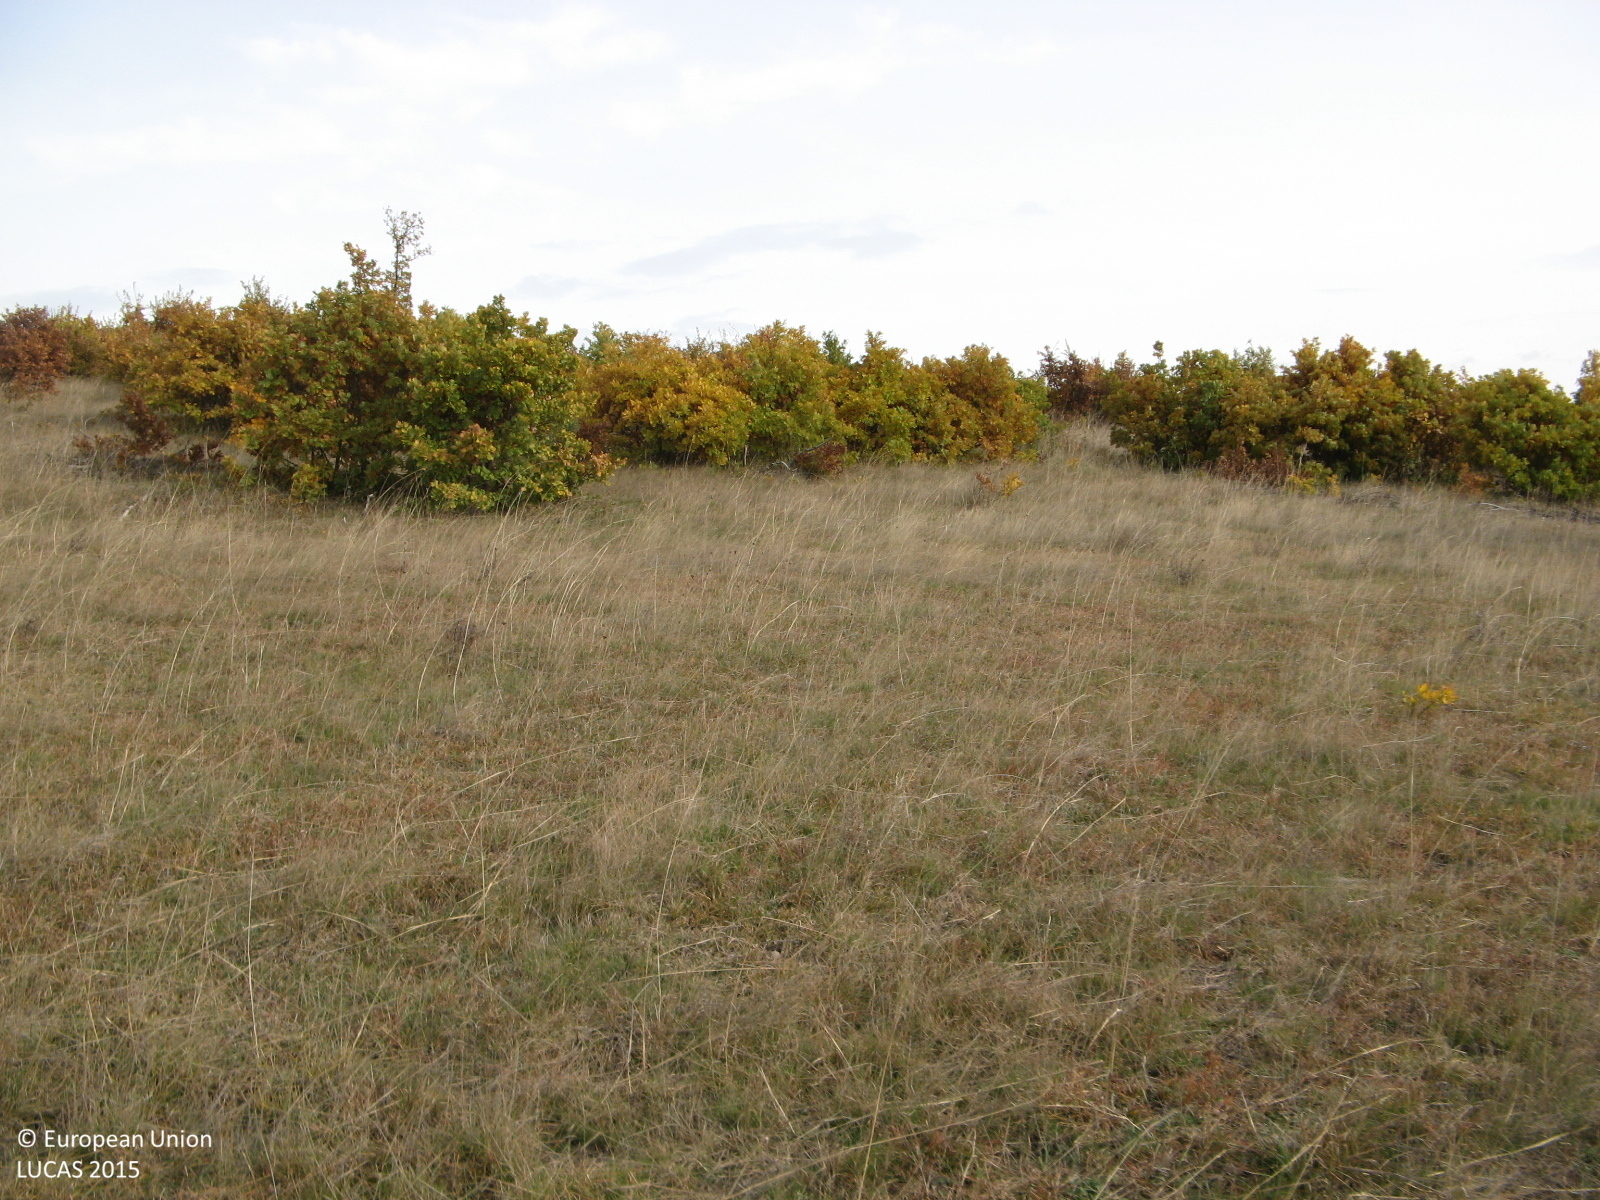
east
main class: Grassland
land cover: Grassland with sparse tree/shrub cover
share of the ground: > 75 %
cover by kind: herbaceous plants 90 %, broadleaved forest trees 5 %, shrubs 5 %
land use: Agriculture (excluding fallow land and kitchen gardens)
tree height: < 5 m
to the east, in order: Grassland with sparse tree/shrub cover; Shrubland without tree cover; Grassland with sparse tree/shrub cover; Shrubland with sparse tree cover; Other mixed woodland; Ditches and canals; Other mixed woodland
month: November
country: BG
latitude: 41.6867
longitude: 25.9886
